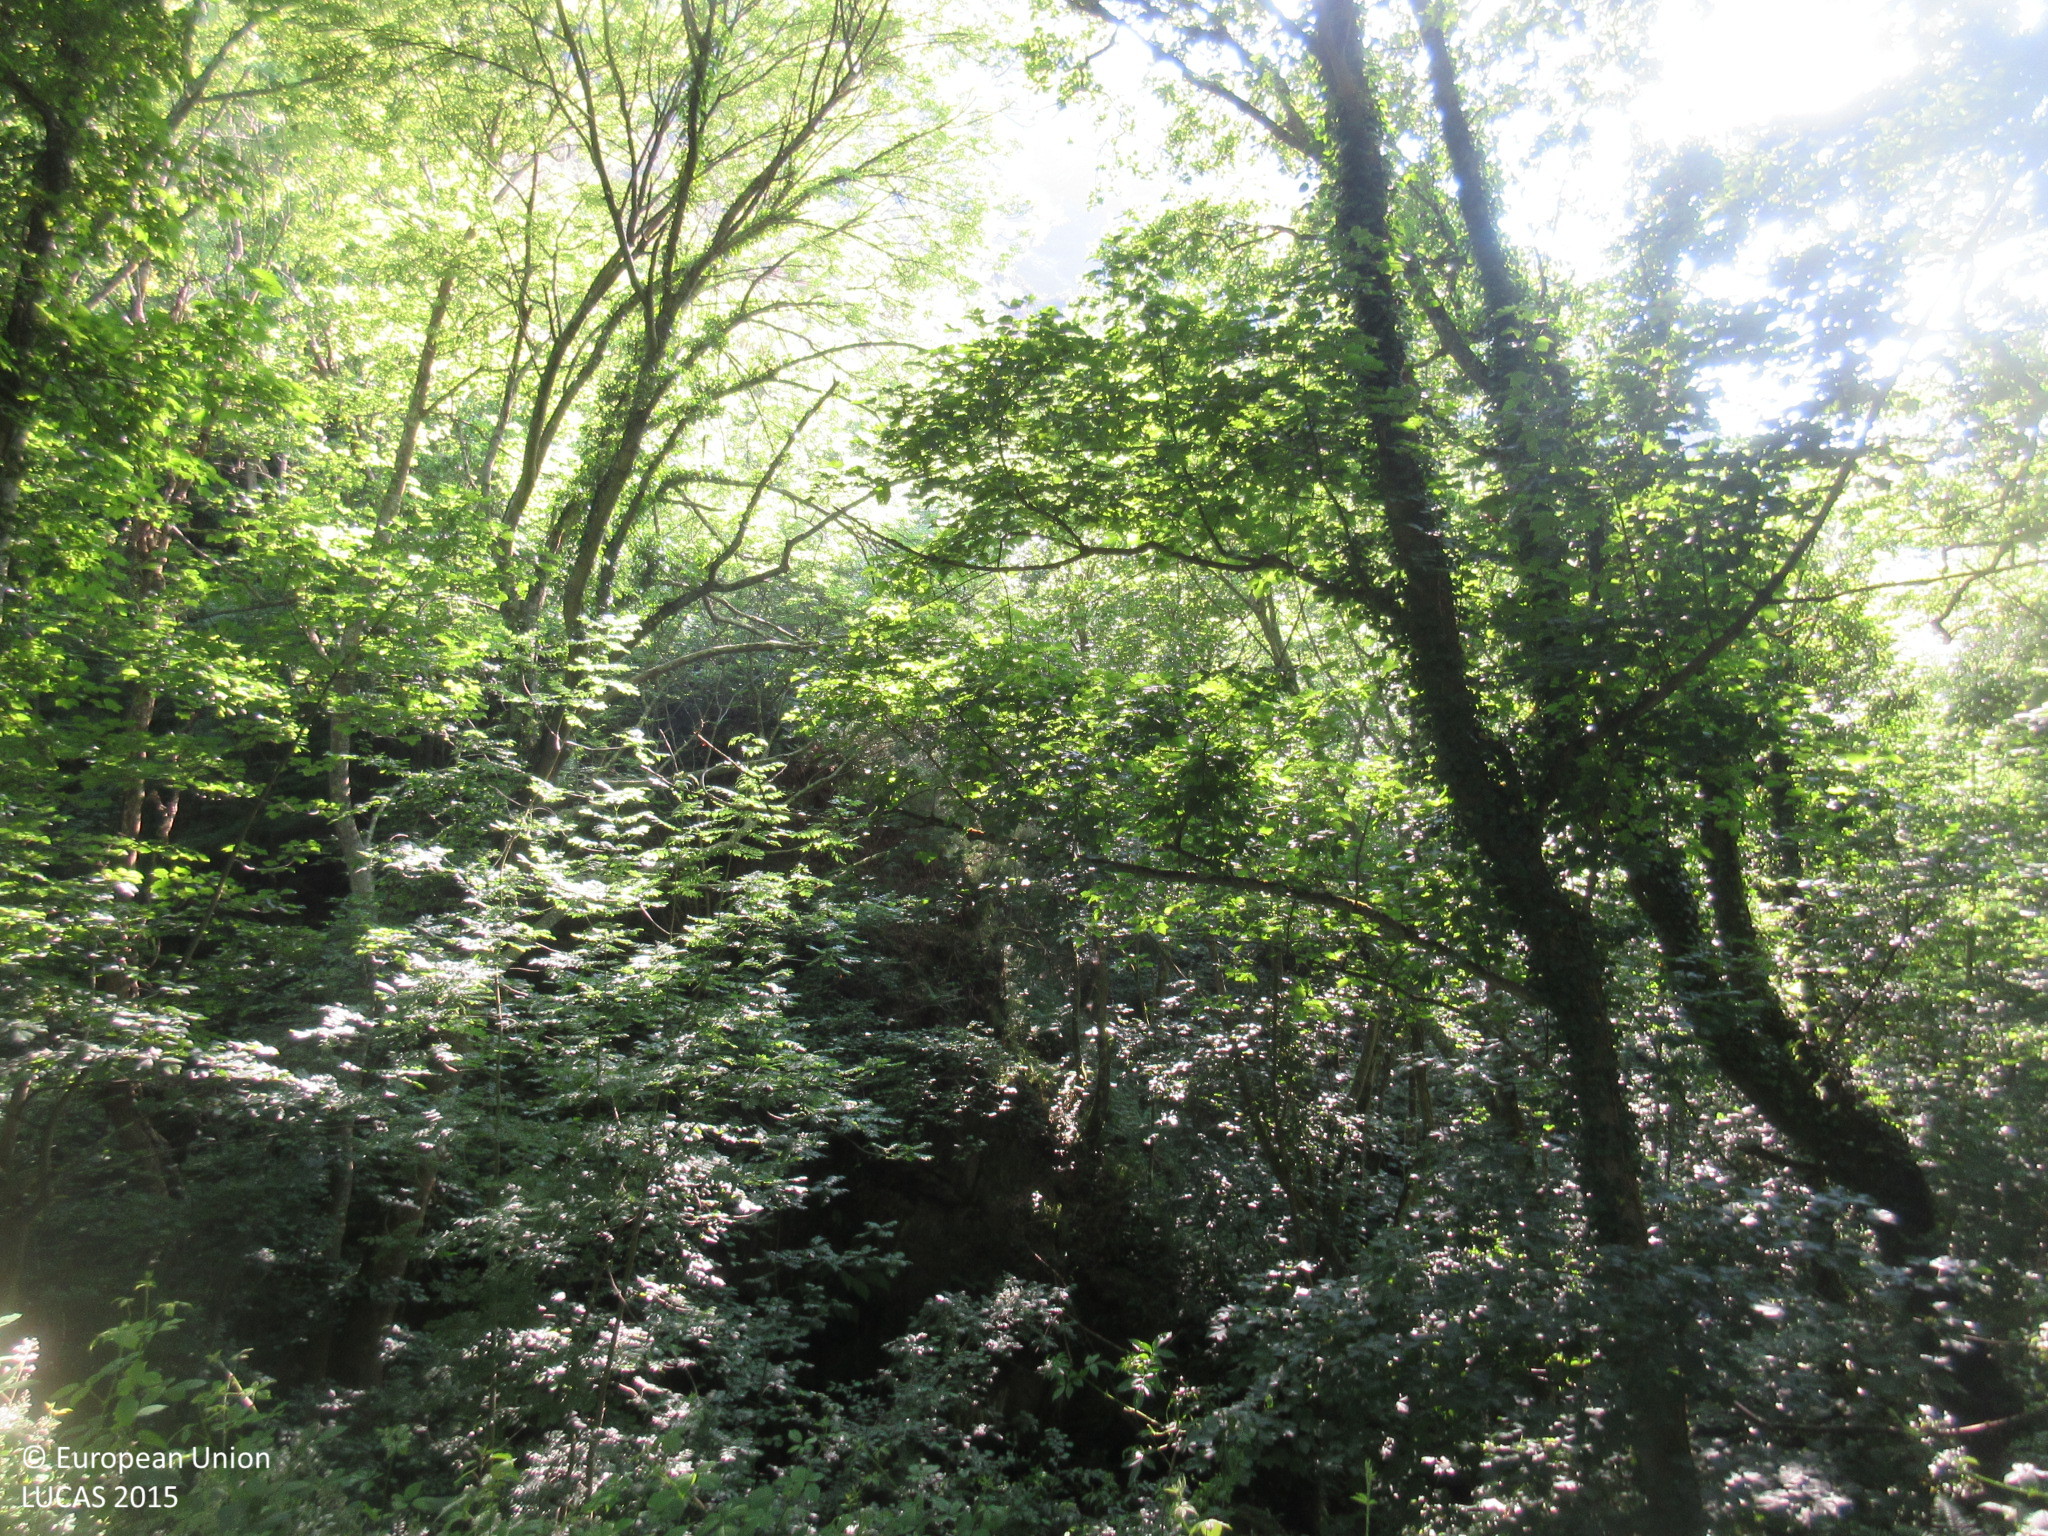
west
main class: Woodland
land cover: Broadleaved woodland
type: acidophilous oak and oak-birch forest
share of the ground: 50 - 75 %
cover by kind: broadleaved forest trees 60 %, shrubs 40 %
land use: Semi-natural and natural areas not in use
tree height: > 5 m
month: June
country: ES
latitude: 43.2757
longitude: -6.2753
